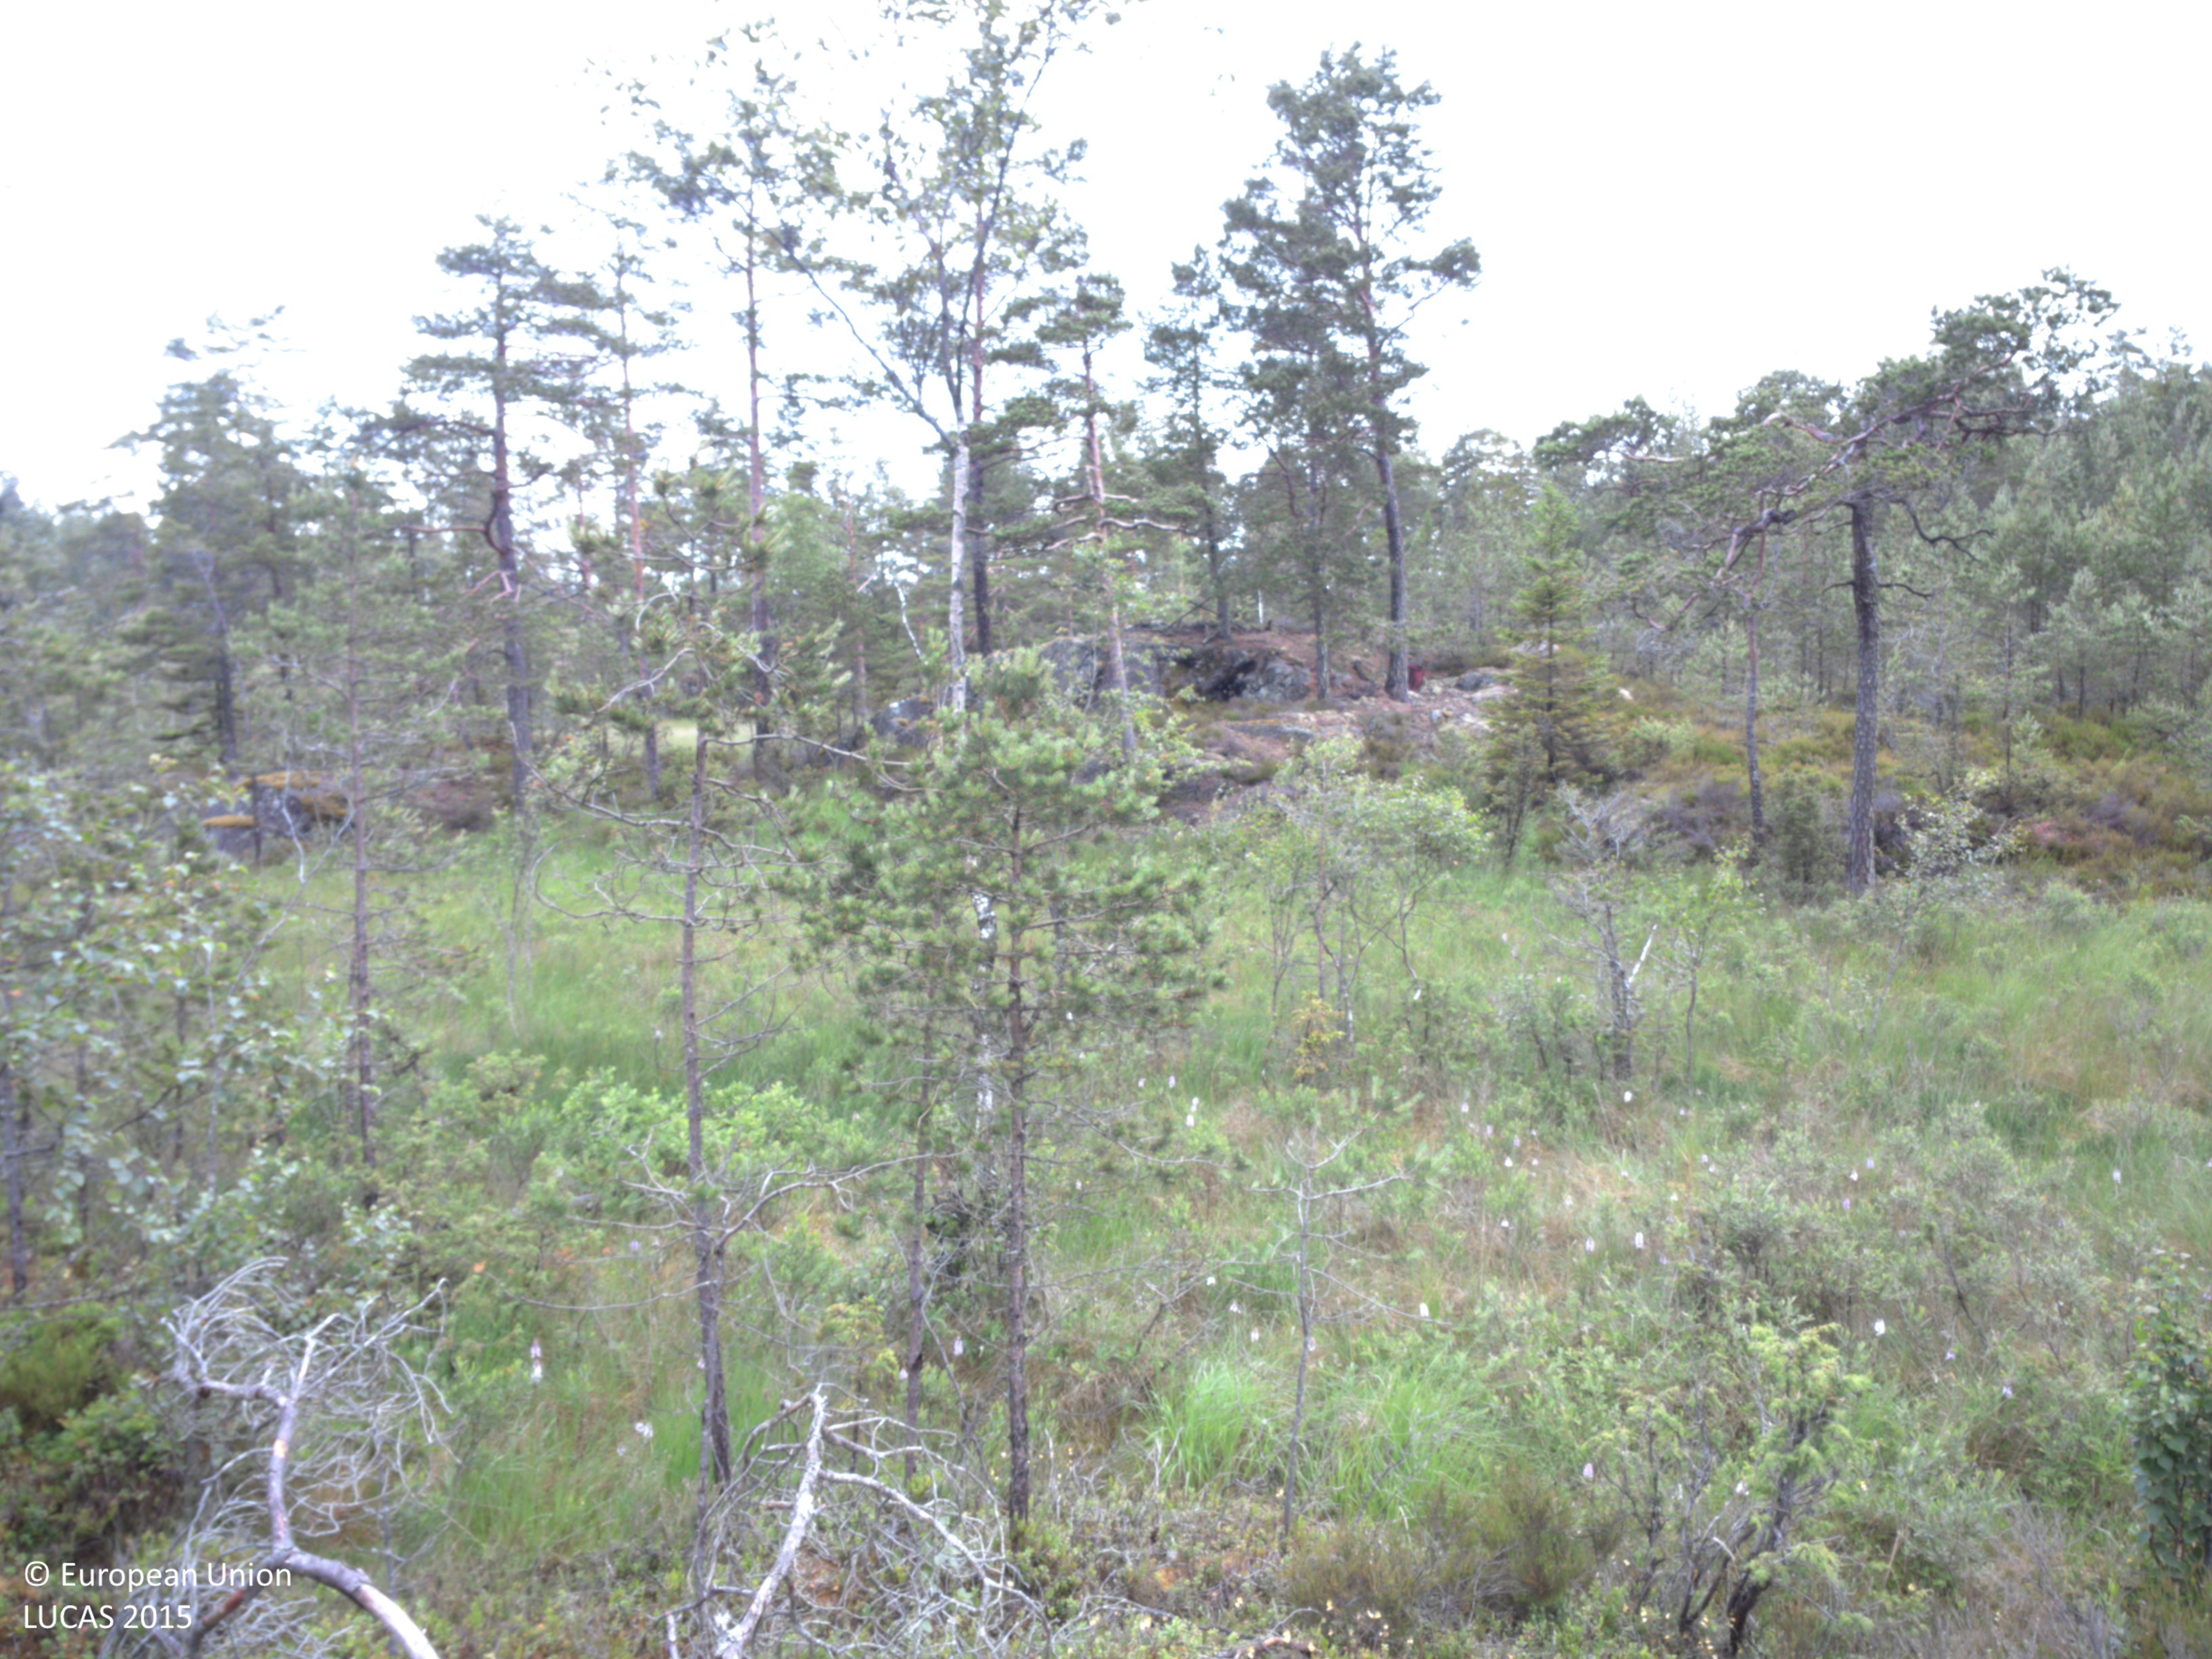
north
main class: Woodland
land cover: Pine dominated coniferous woodland
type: boreal forest
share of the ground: 25 - 50 %
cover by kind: coniferous forest trees 25 %, herbaceous plants 25 %, lichens and mosses 25 %, shrubs 15 %, consolidated bare surface 10 %
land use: Forestry
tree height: > 5 m
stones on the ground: < 10 %
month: July
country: SE
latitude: 58.7044
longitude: 12.2562
